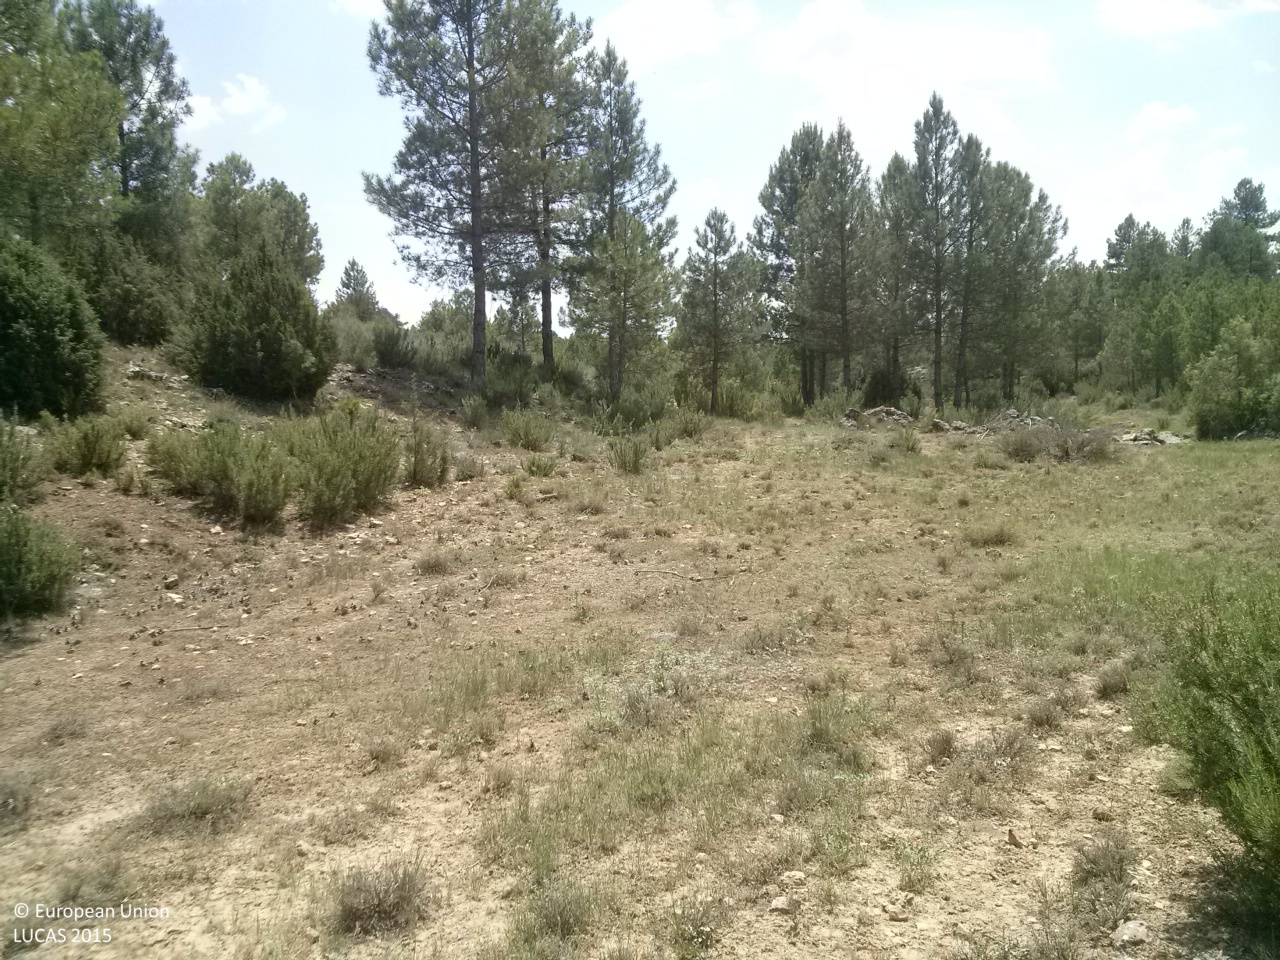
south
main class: Woodland
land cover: Pine dominated coniferous woodland
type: coniferous forest of the mediterranean region
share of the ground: 10 - 25 %
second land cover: Shrubland without tree cover
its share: 25 - 50 %
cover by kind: shrubs 50 %, herbaceous plants 30 %, coniferous forest trees 10 %, unconsolidated bare surface 10 %
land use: Forestry
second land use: Agriculture (excluding fallow land and kitchen gardens)
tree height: > 5 m
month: June
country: ES
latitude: 39.8474
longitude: -1.7793
